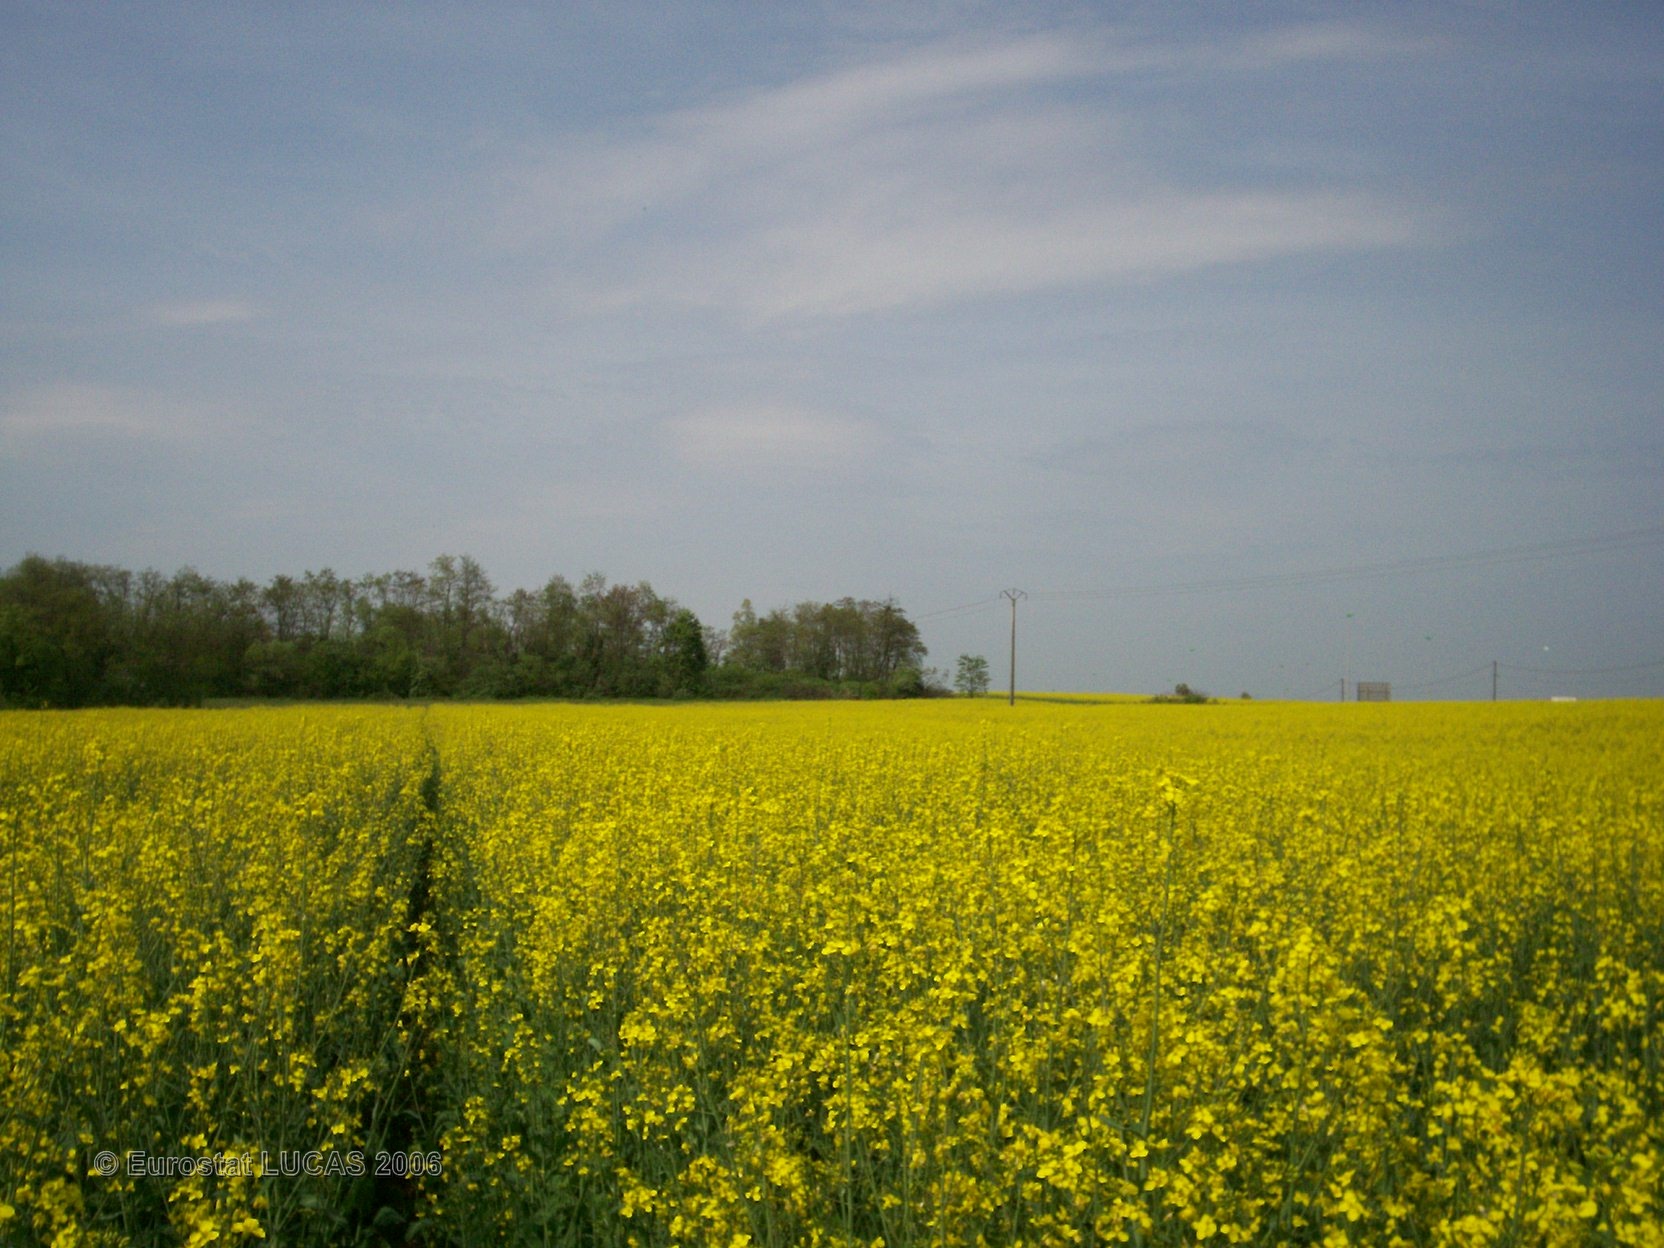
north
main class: Cropland
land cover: Rape and turnip rape
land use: Agriculture (excluding fallow land and kitchen gardens)
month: May
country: FR
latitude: 46.0222
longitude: 4.7195
